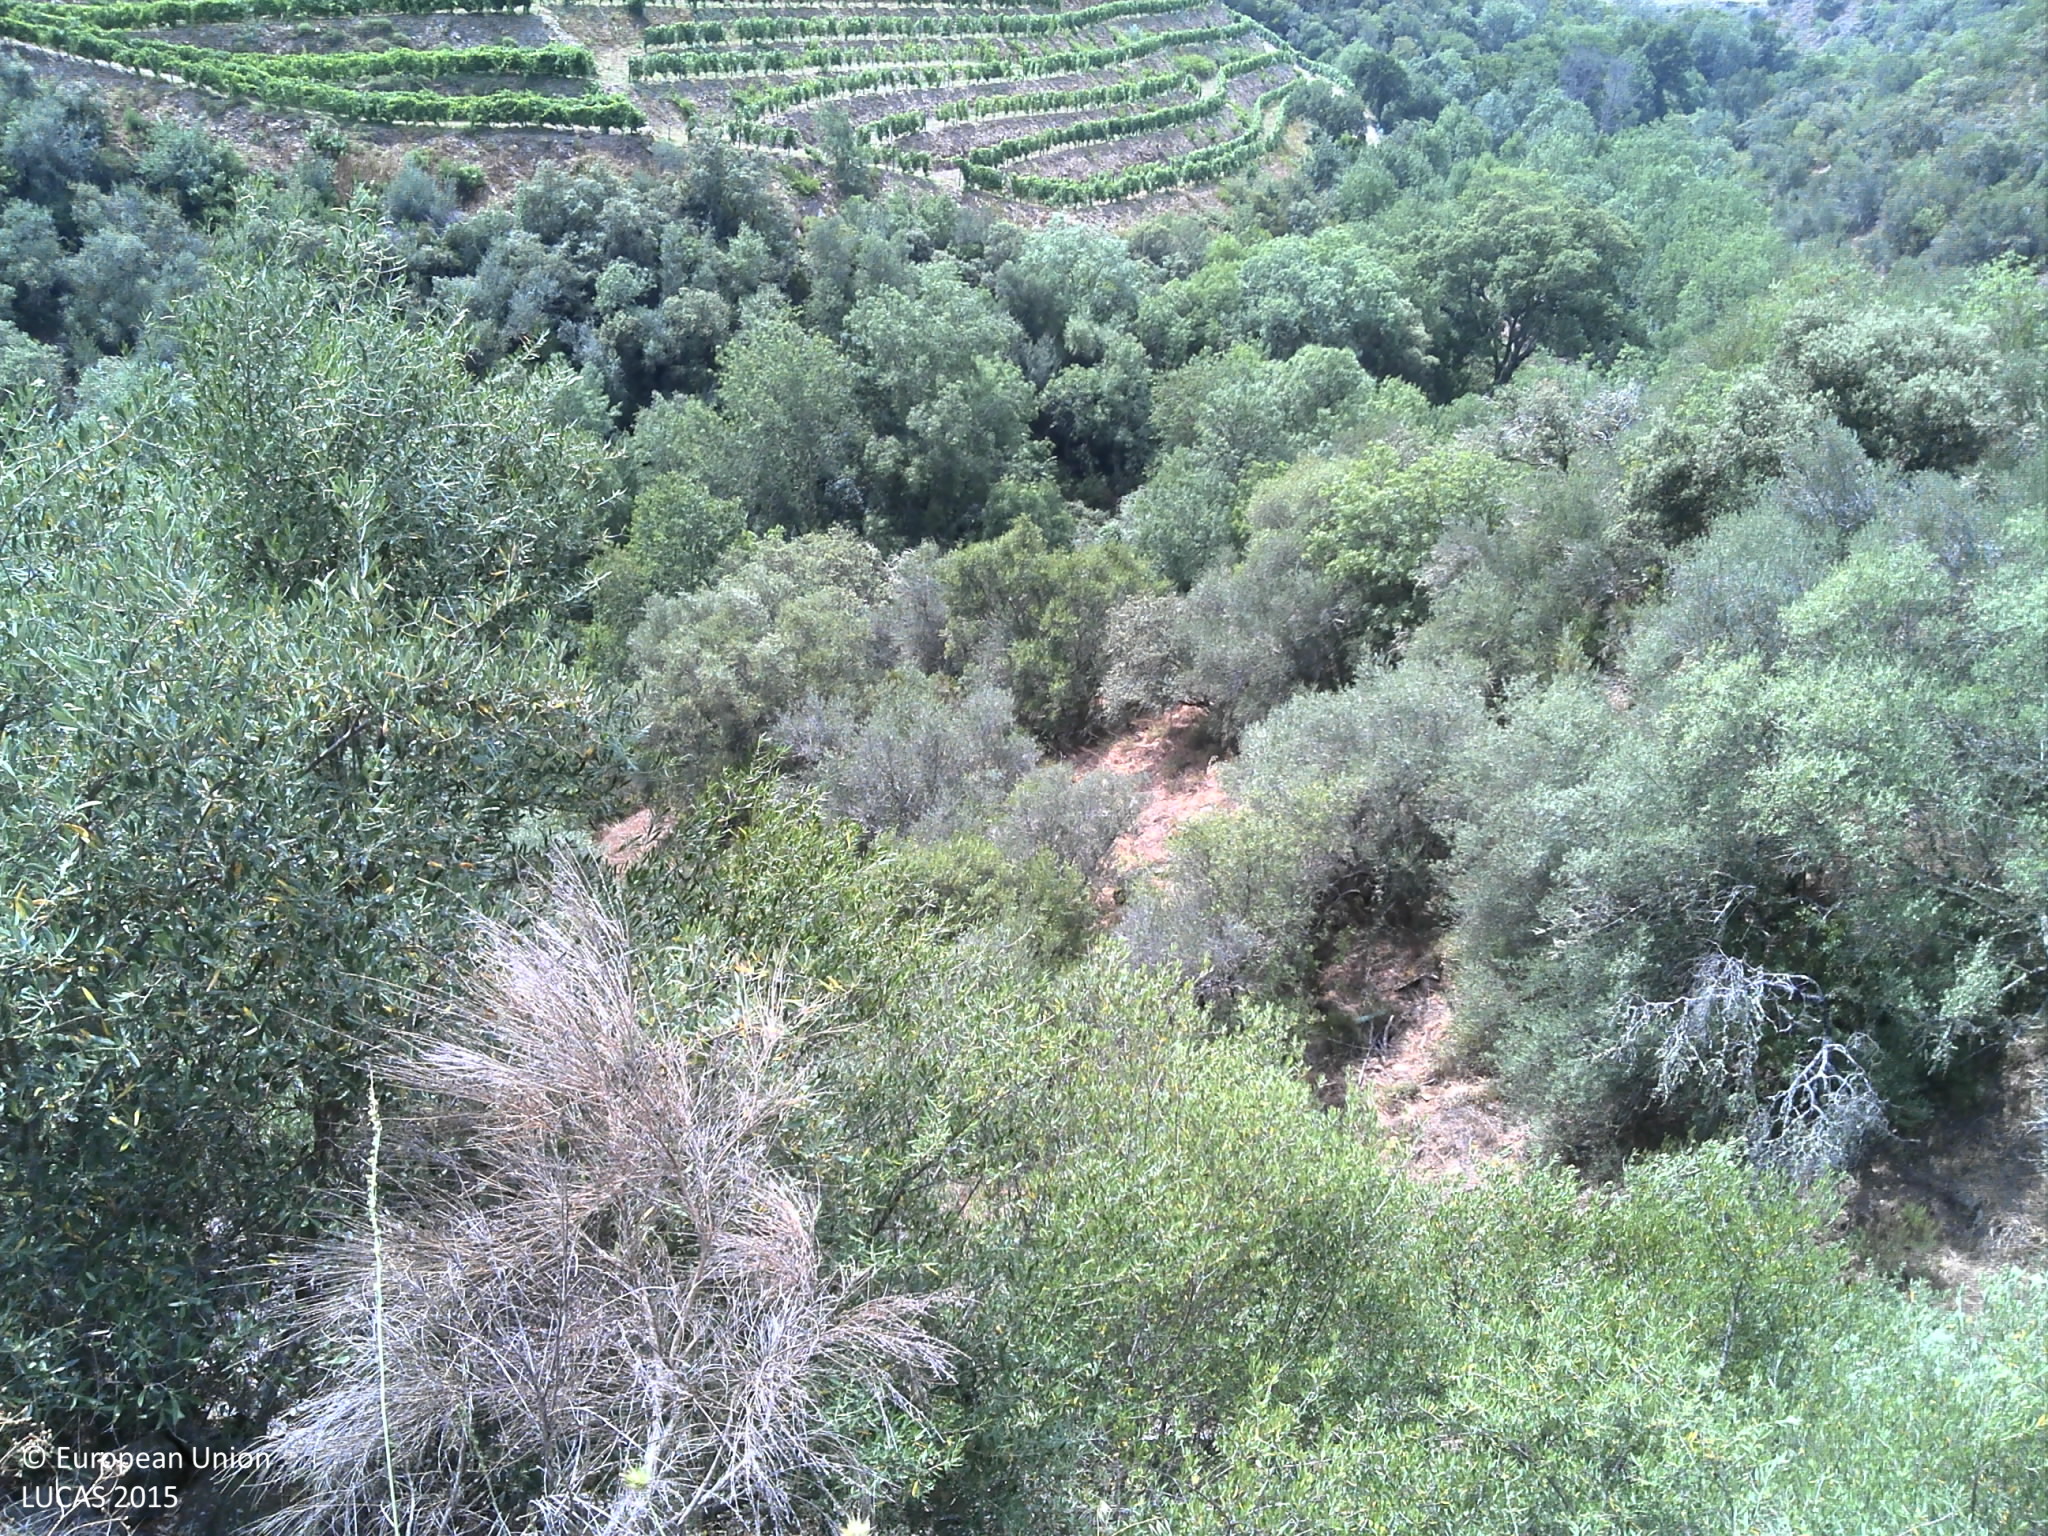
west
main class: Cropland
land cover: Olive groves
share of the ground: < 10 %
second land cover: Shrubland without tree cover
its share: 50 - 75 %
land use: Abandoned areas
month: June
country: PT
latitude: 41.1386
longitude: -7.4789
